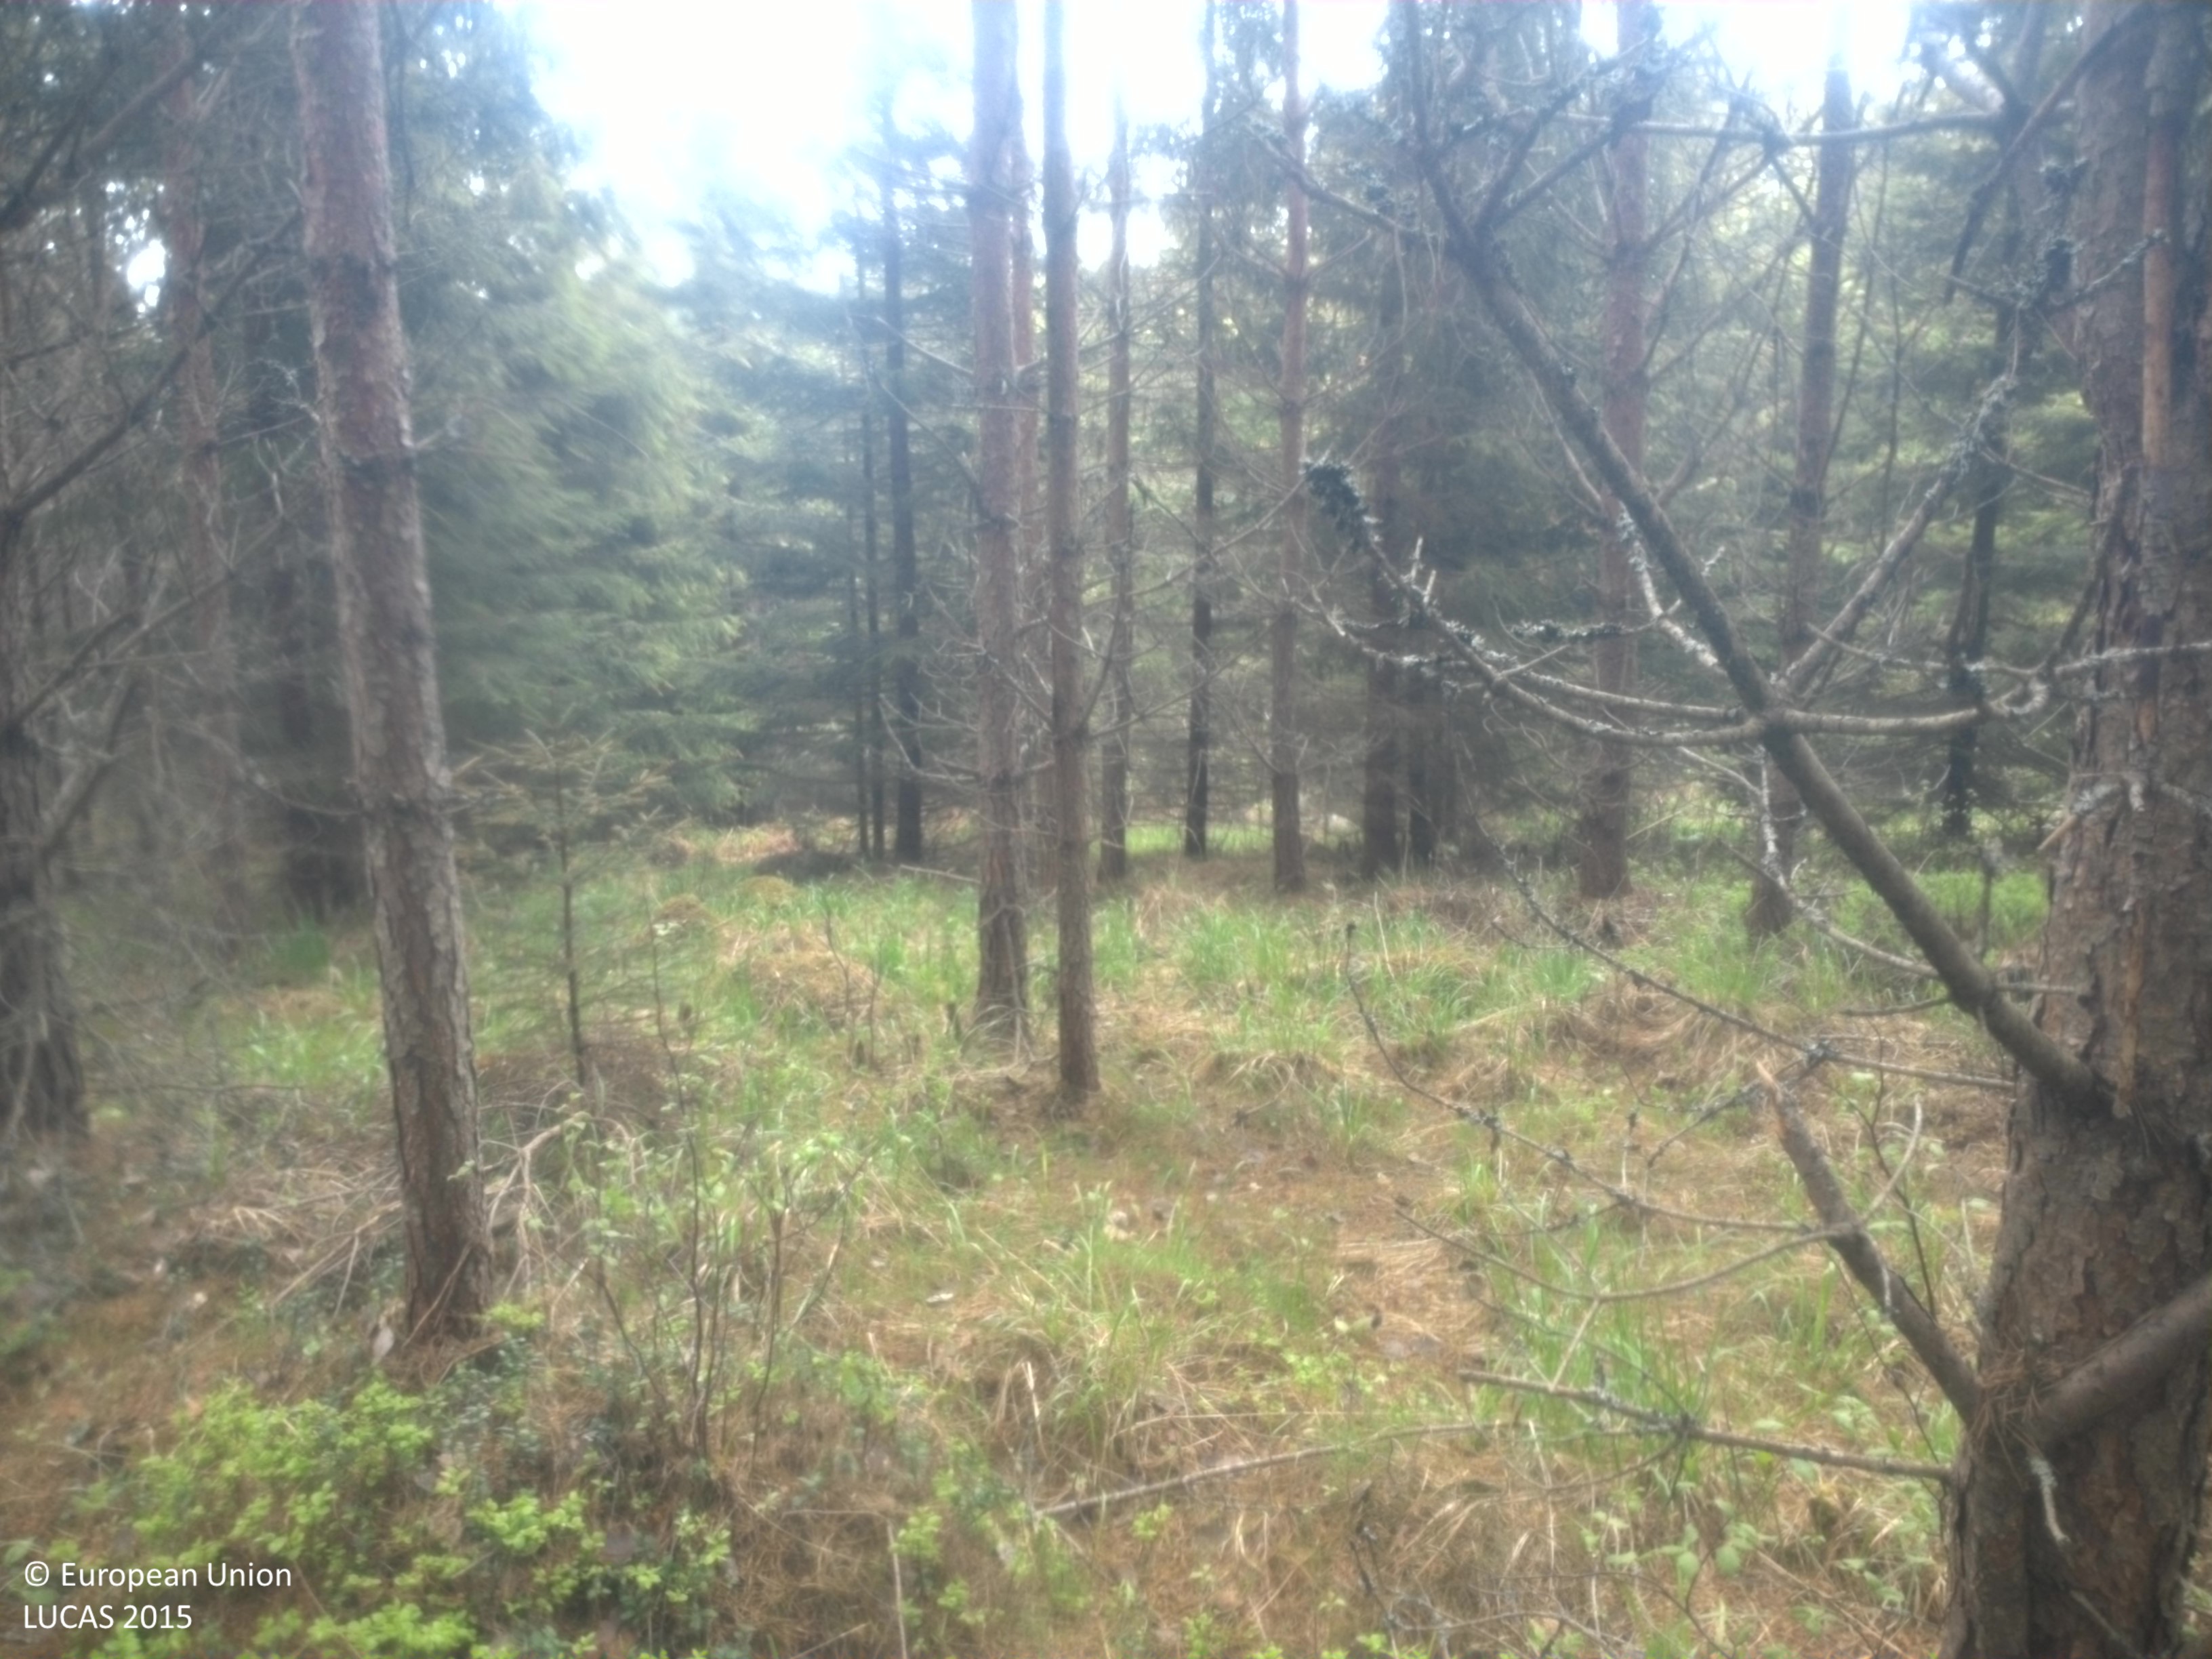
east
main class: Woodland
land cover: Pine dominated coniferous woodland
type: boreal forest
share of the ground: 25 - 50 %
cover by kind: coniferous forest trees 45 %, shrubs 30 %, herbaceous plants 10 %, lichens and mosses 10 %, broadleaved forest trees 5 %
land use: Forestry
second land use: Amenities, museums, leisure
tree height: > 5 m
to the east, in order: Pine dominated coniferous woodland; Spruce dominated coniferous woodland; Shrubland with sparse tree cover; Grass margins; Paved roads, cycling and walking lanes; Grass margins; Spruce dominated coniferous woodland; Rivers and streams; Spruce dominated coniferous woodland; Tracks; Spruce dominated coniferous woodland
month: May
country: SE
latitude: 59.5843
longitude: 12.3844
